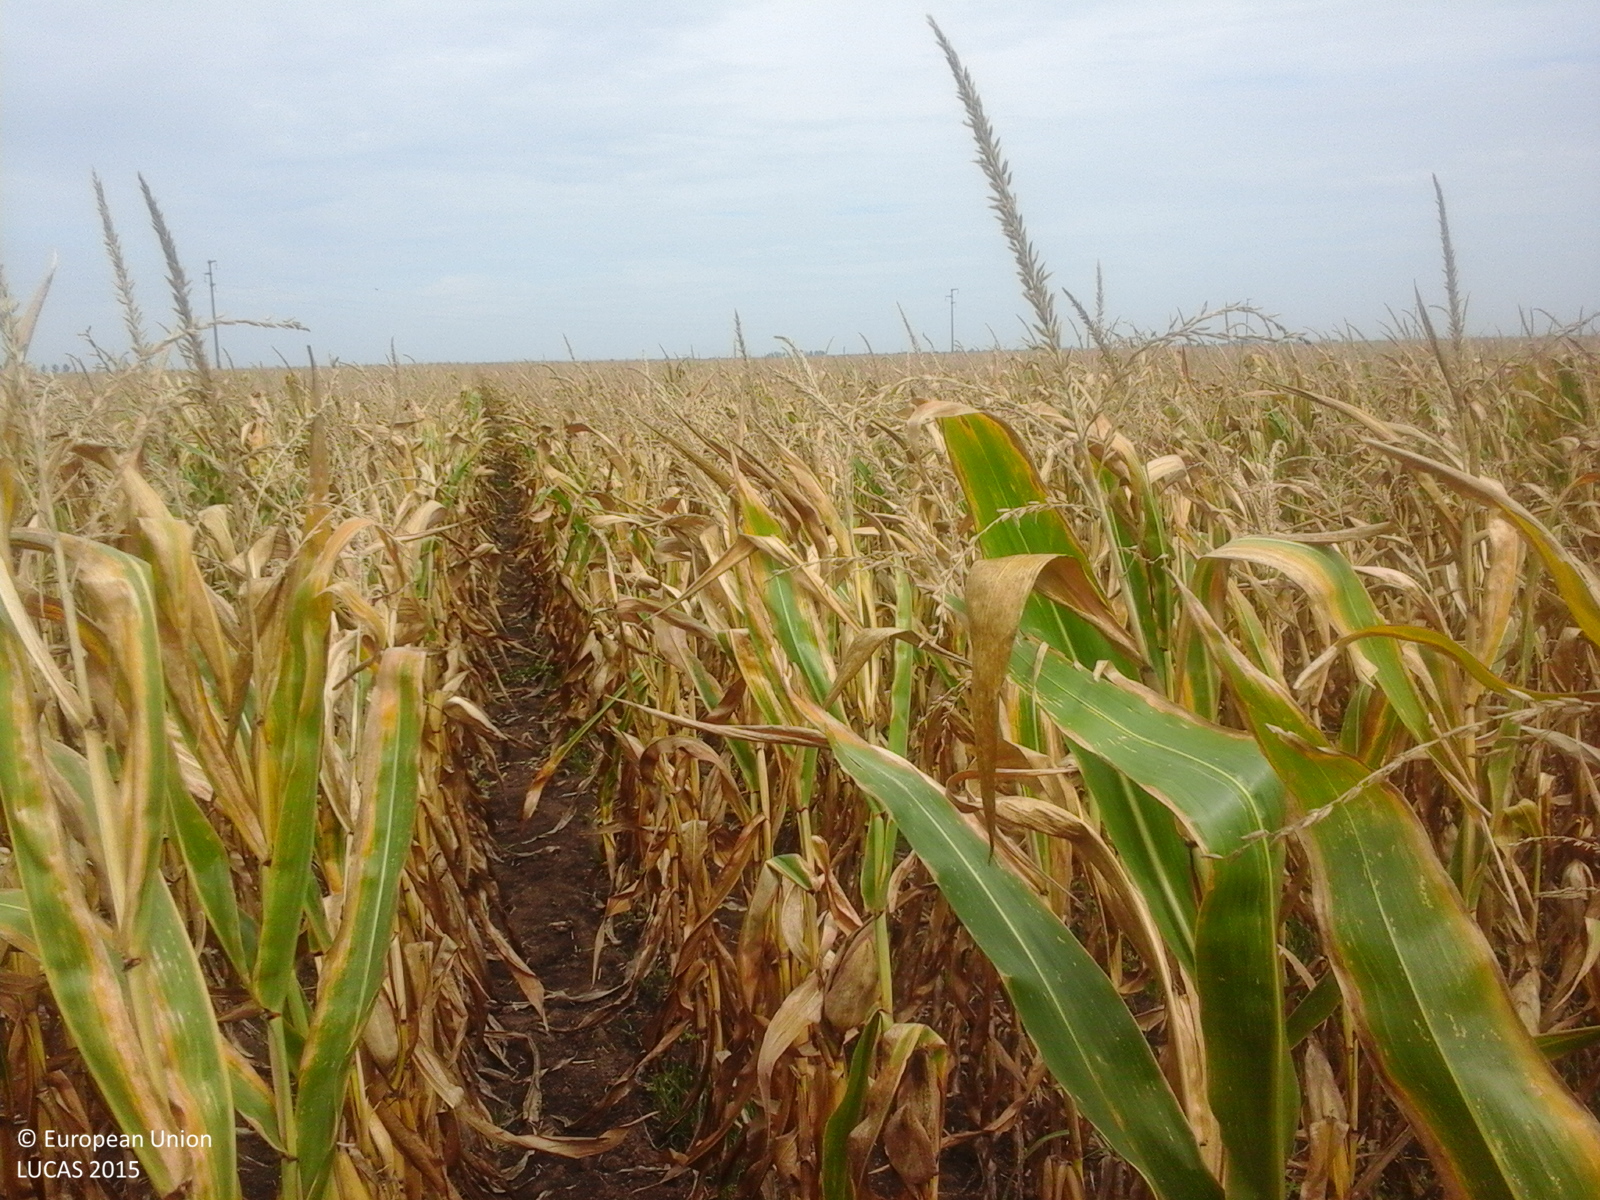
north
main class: Cropland
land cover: Maize
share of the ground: > 75 %
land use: Agriculture (excluding fallow land and kitchen gardens)
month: August
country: RO
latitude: 46.3431
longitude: 21.5362
